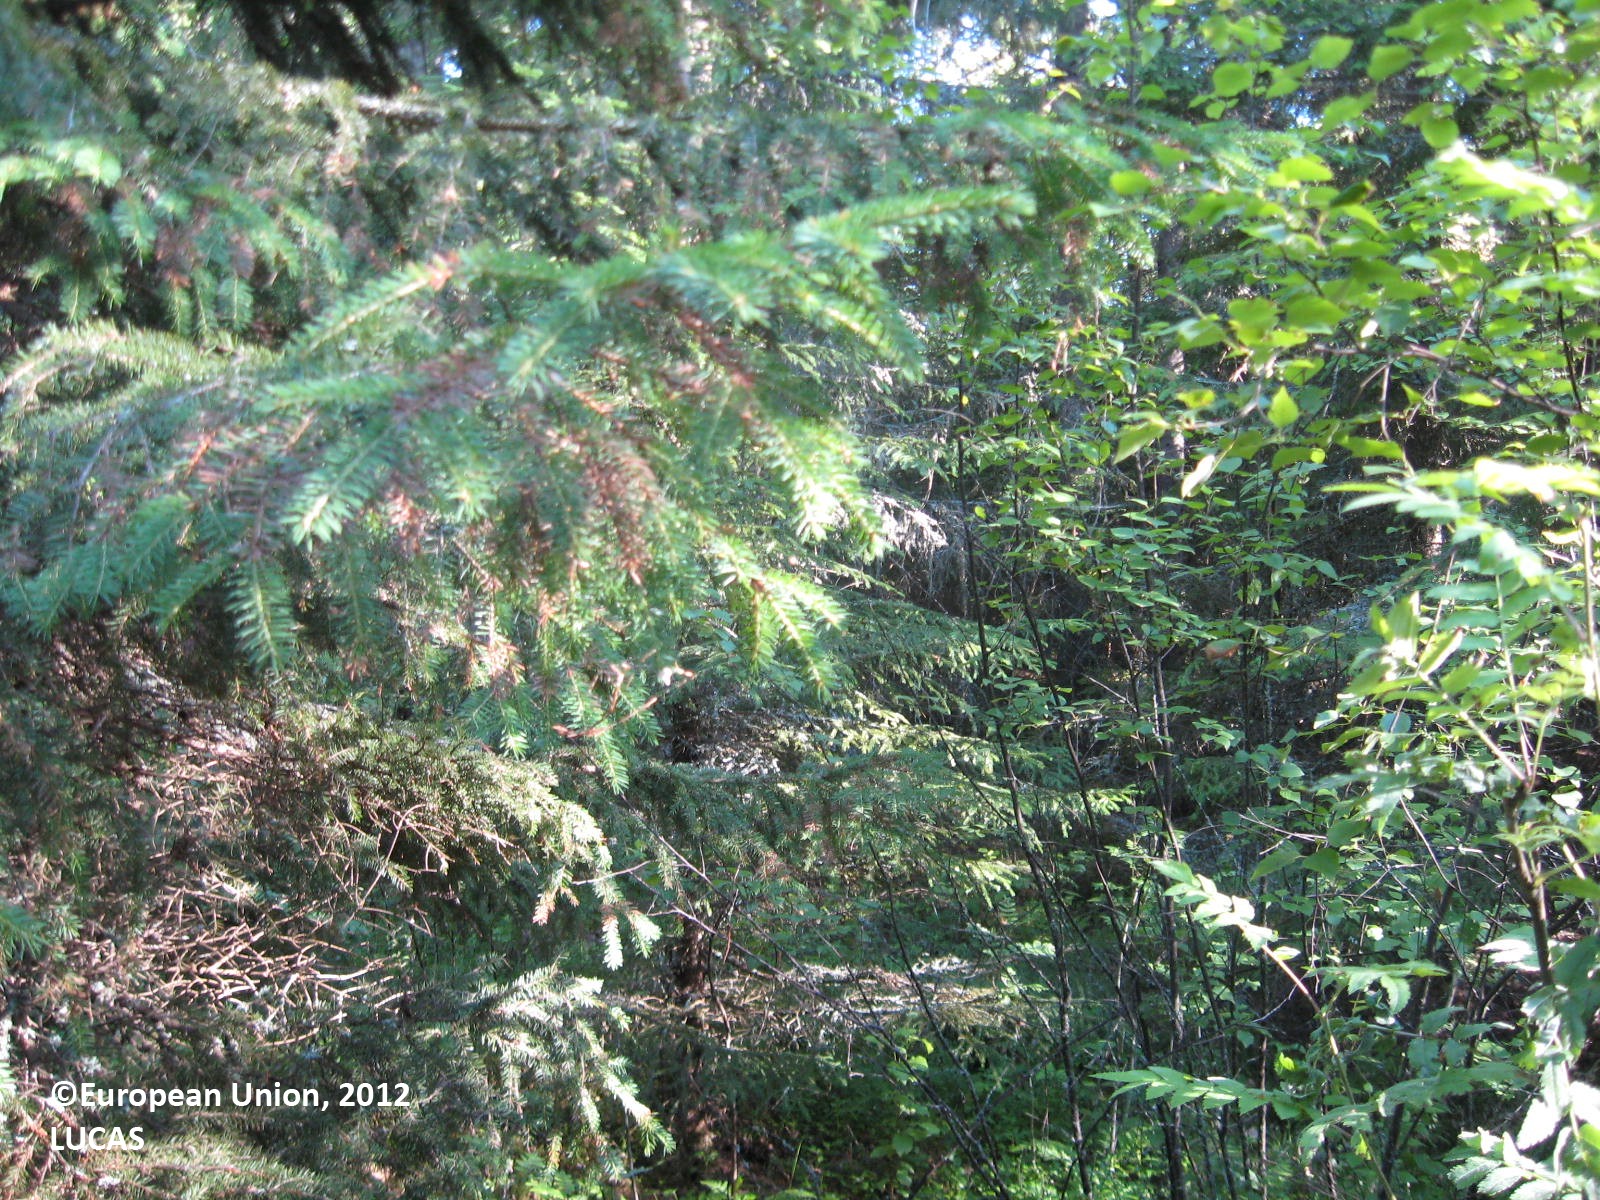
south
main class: Woodland
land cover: Spruce dominated coniferous woodland
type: boreal forest
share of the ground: > 75 %
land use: Forestry
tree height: > 5 m
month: July
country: FI
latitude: 62.1696
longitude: 21.5086
